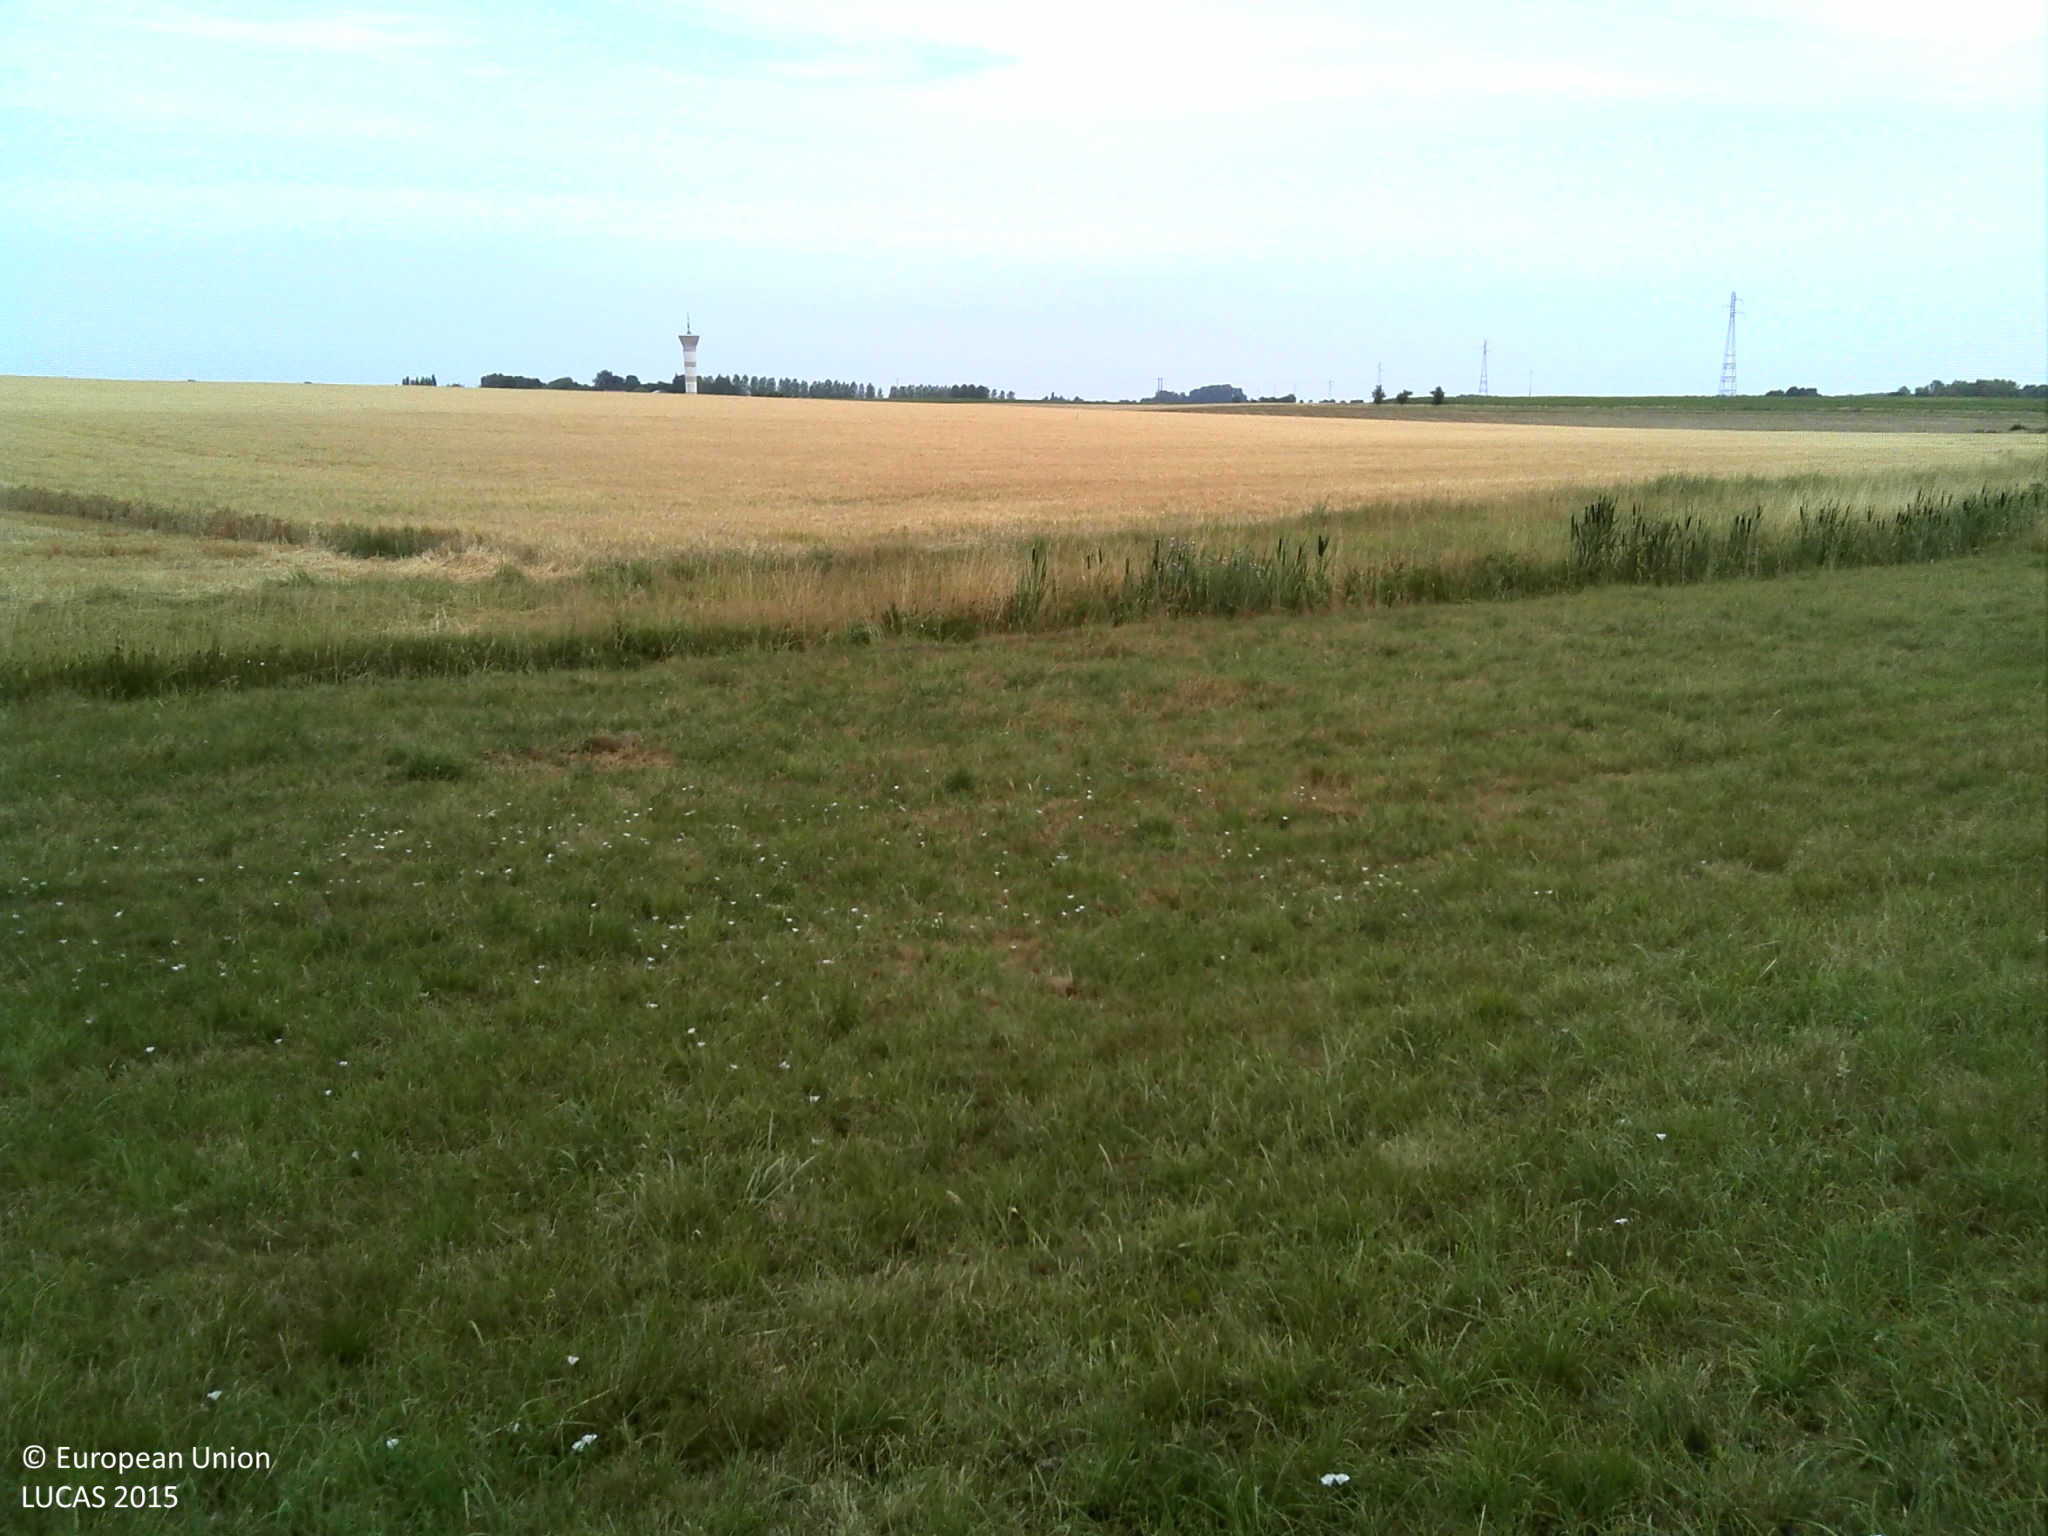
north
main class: Grassland
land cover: Grassland without tree/shrub cover
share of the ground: > 75 %
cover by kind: herbaceous plants 100 %
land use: Agriculture (excluding fallow land and kitchen gardens)
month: July
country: FR
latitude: 48.5457
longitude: 4.6741
